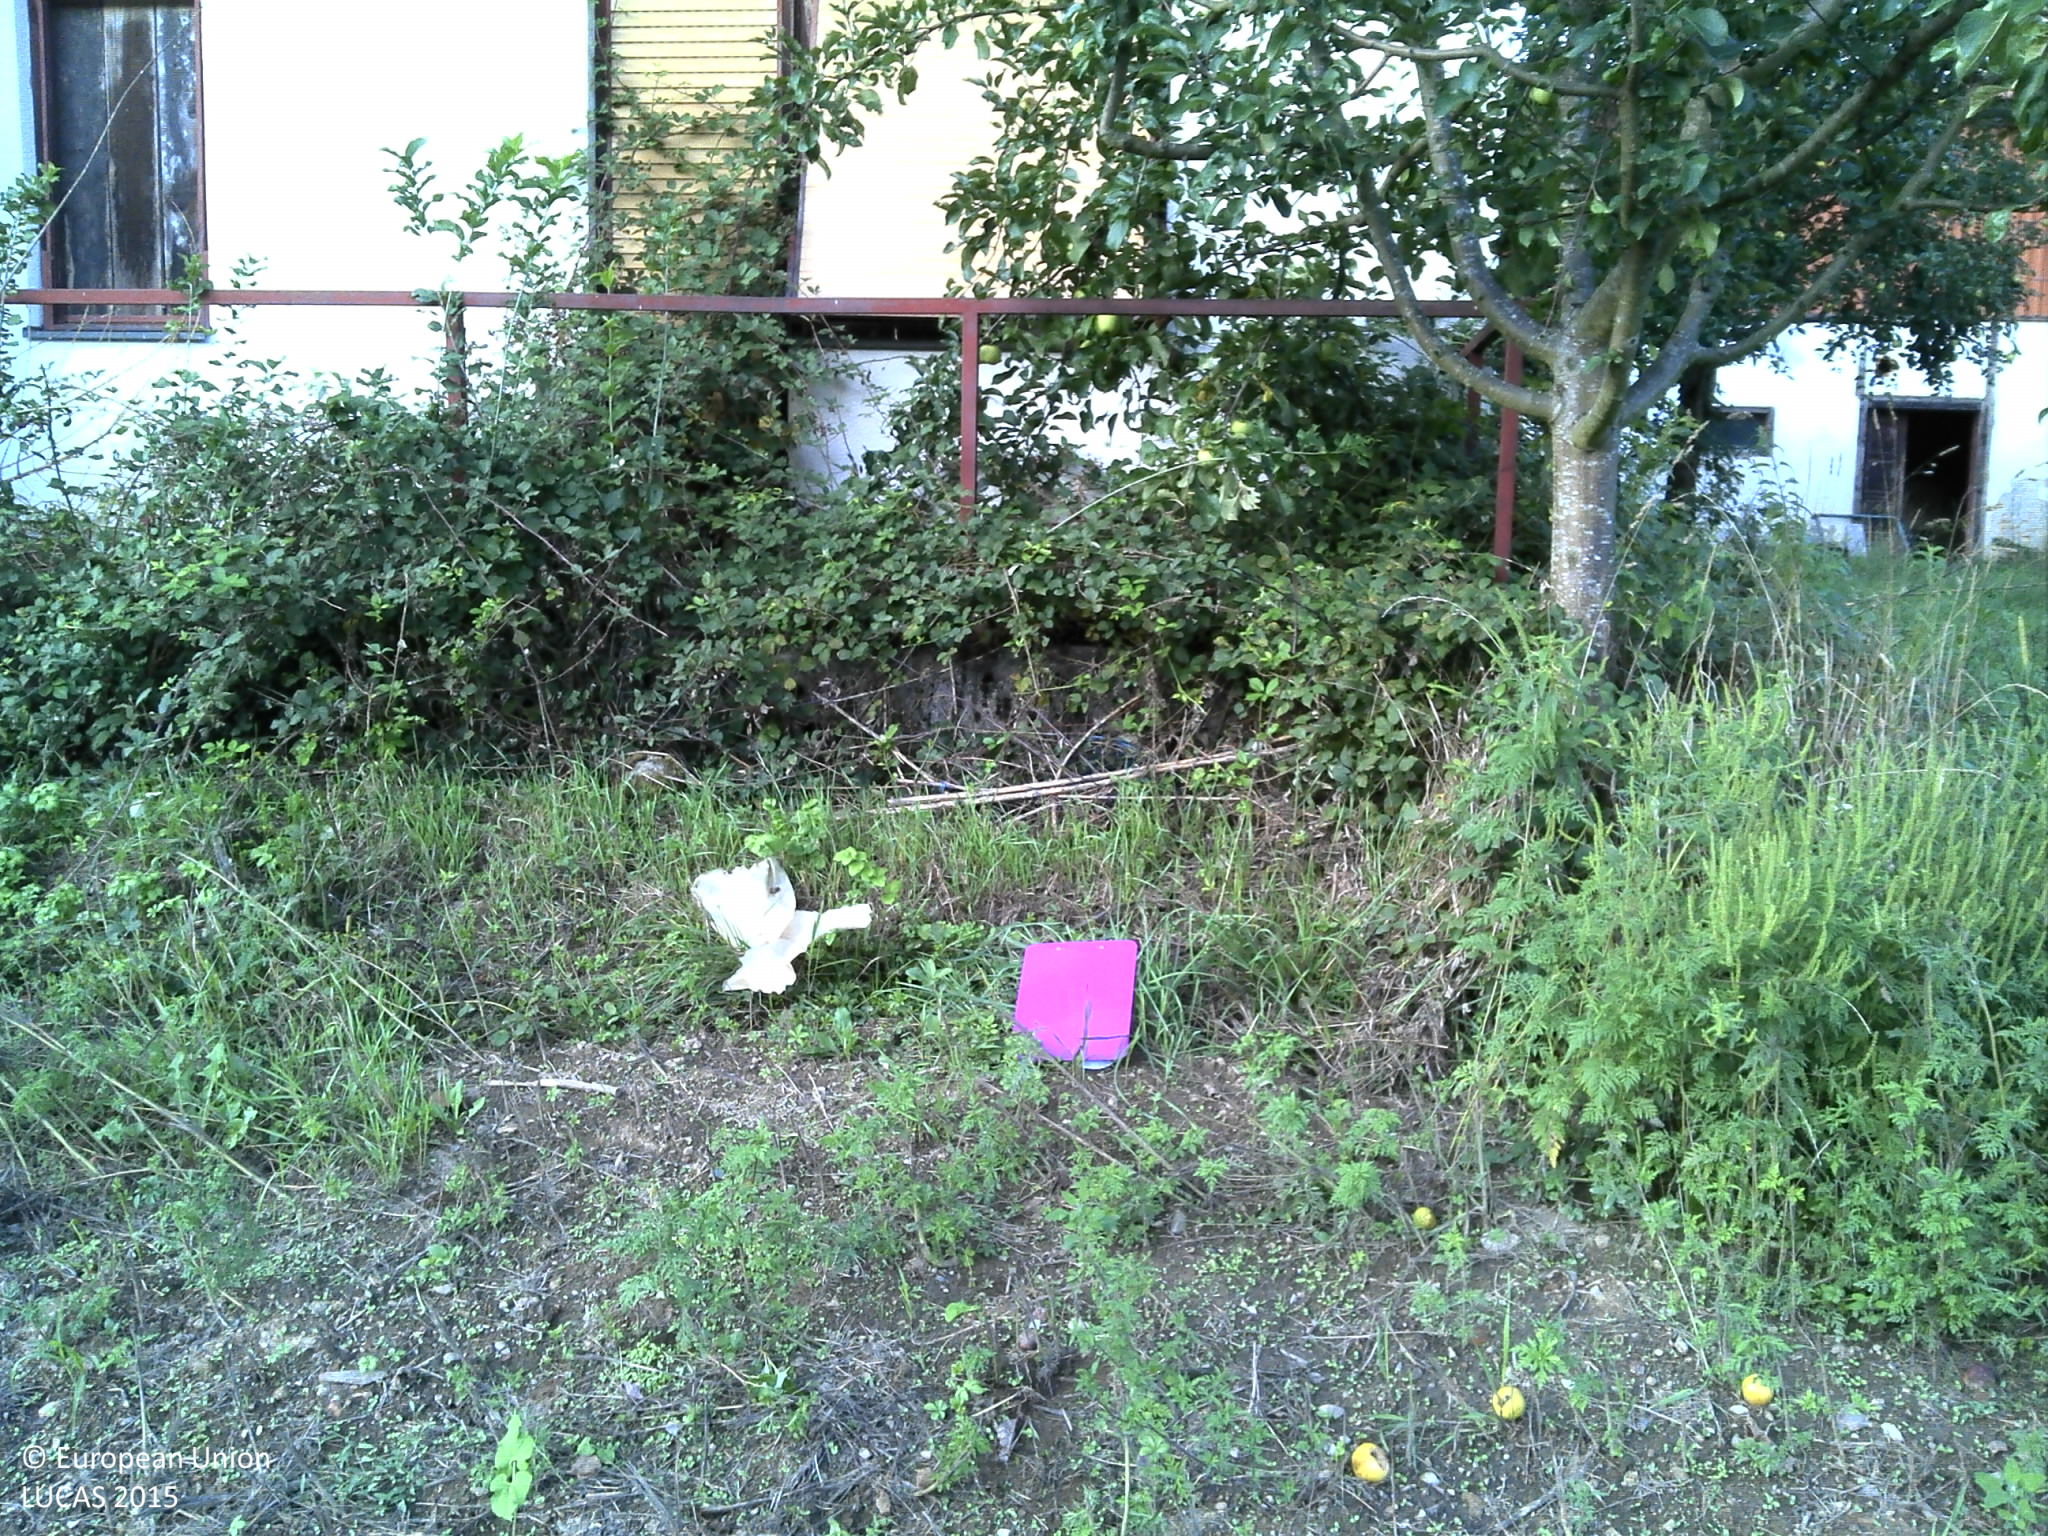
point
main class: Grassland
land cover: Grassland with sparse tree/shrub cover
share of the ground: > 75 %
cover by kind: herbaceous plants 90 %, broadleaved forest trees 5 %, shrubs 5 %
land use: Residential
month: August
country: HR
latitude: 45.2605
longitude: 15.6923
